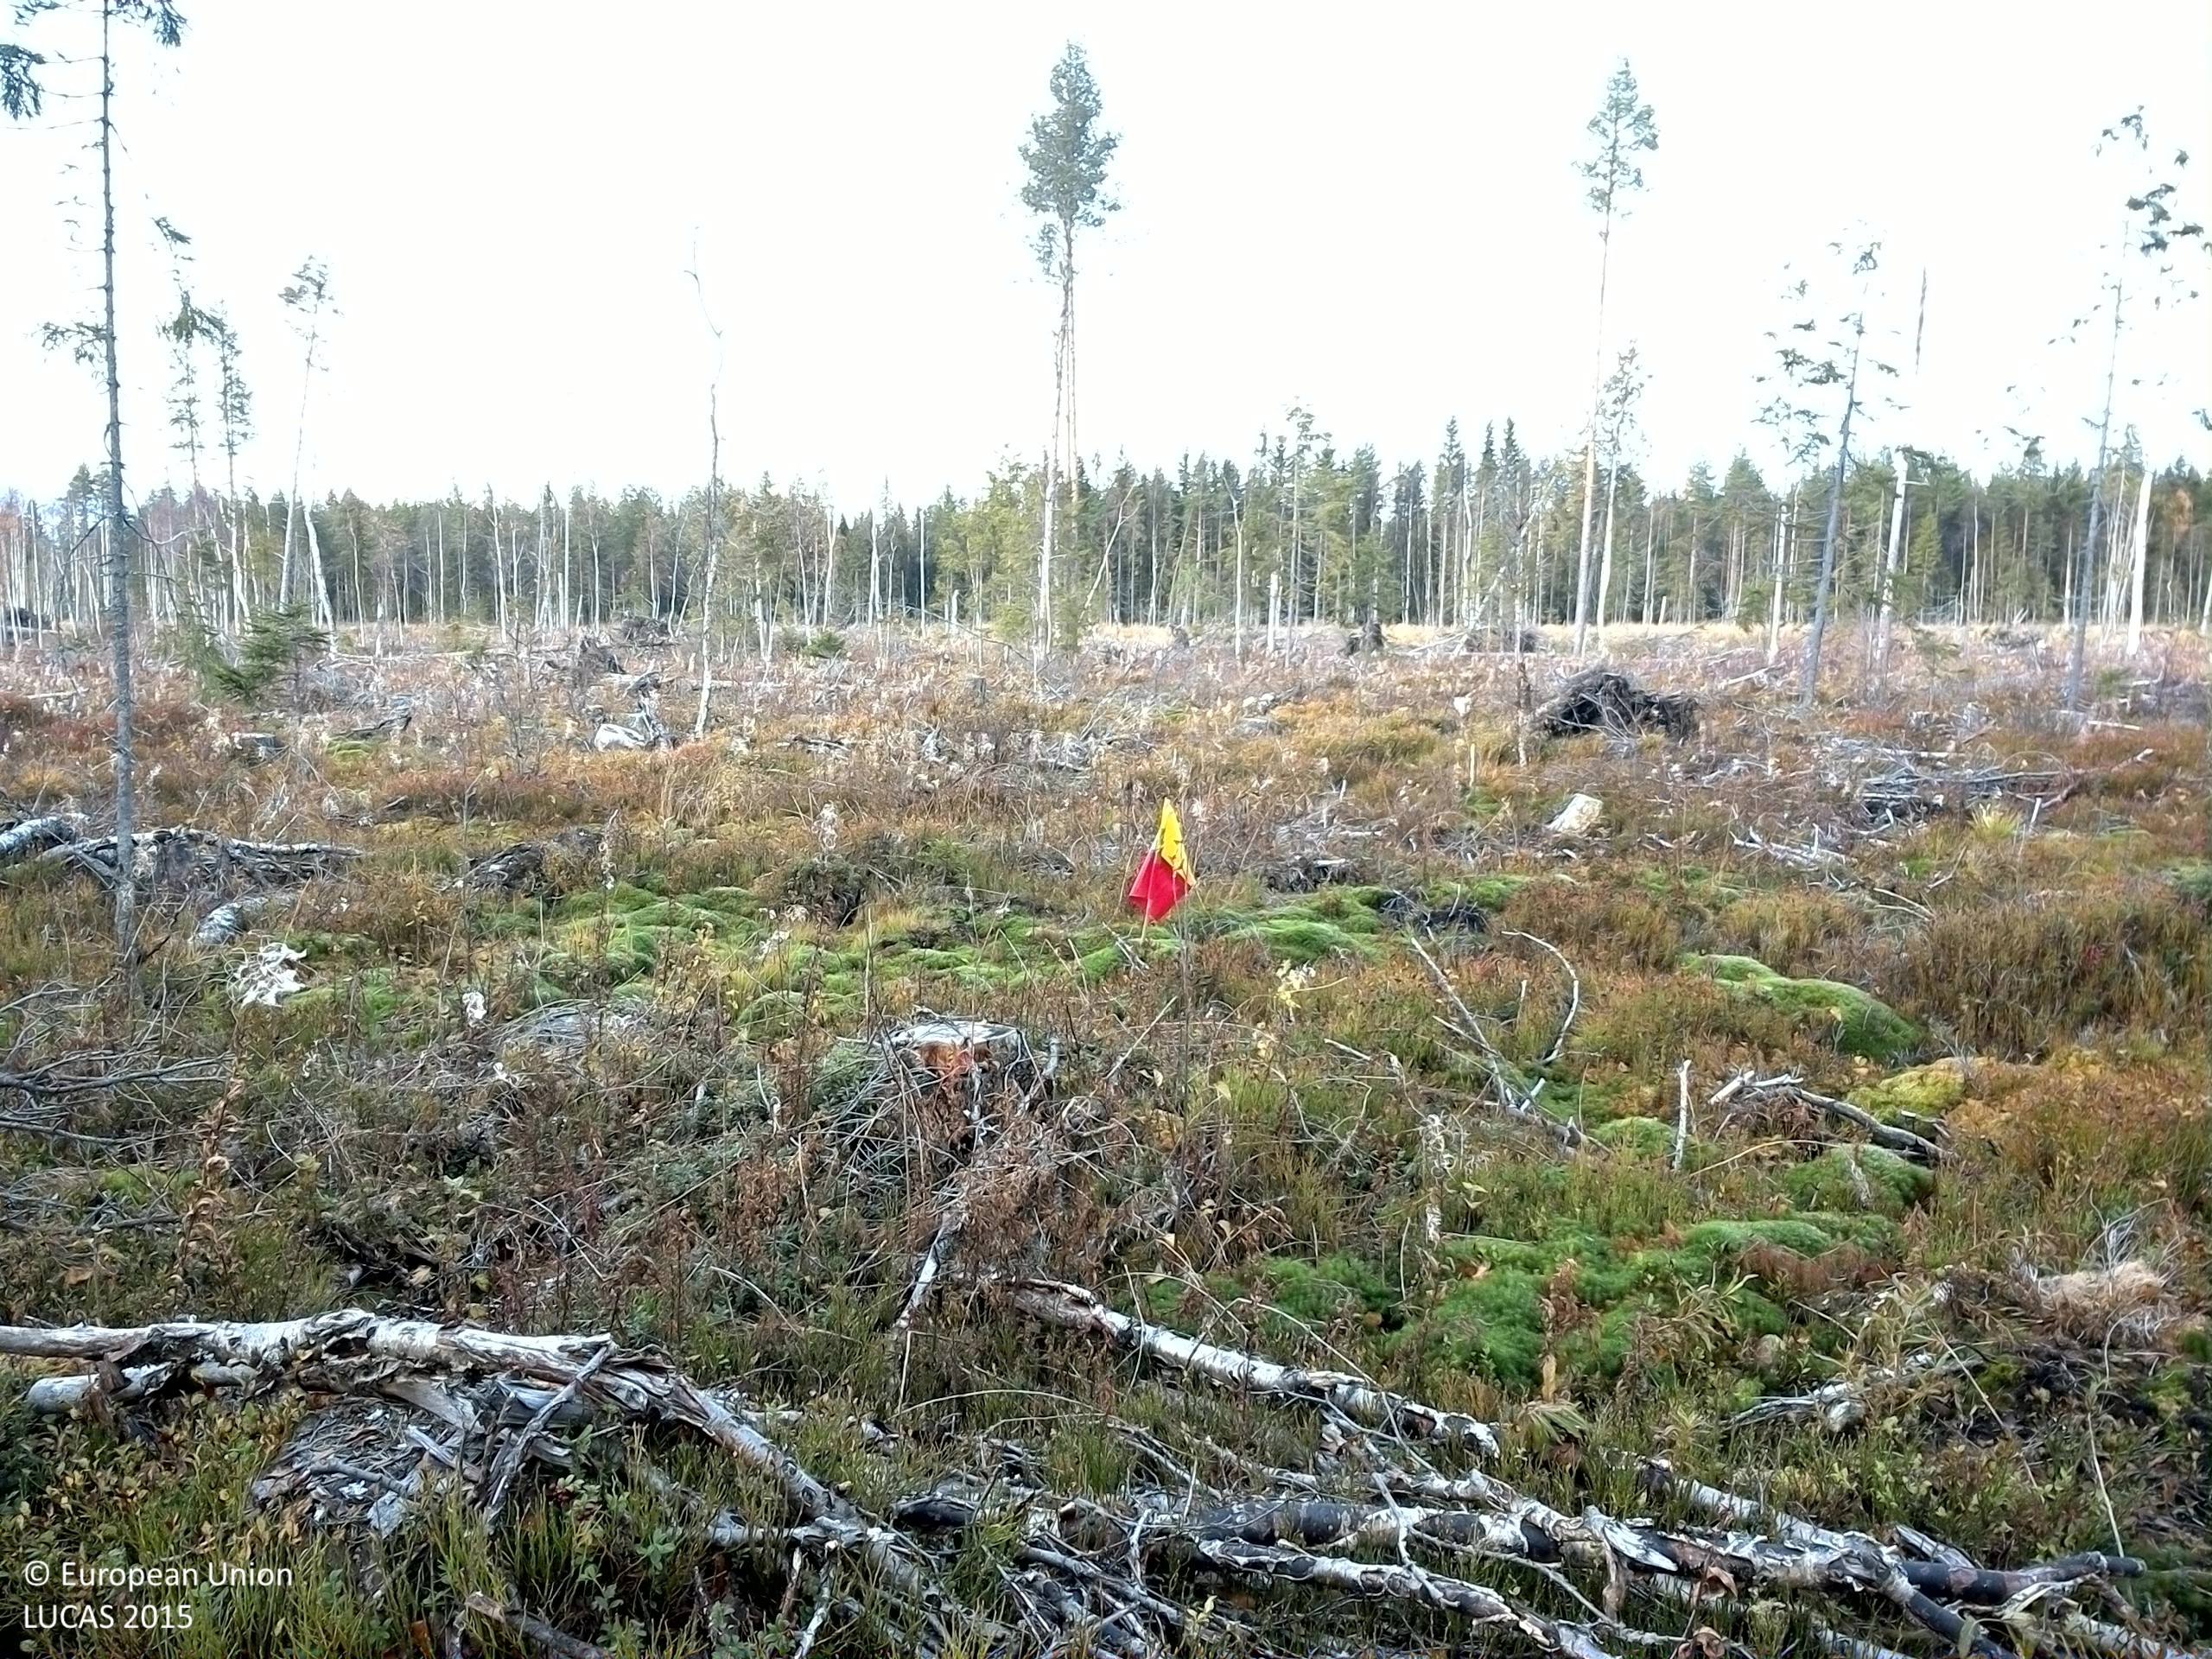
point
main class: Shrubland
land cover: Shrubland without tree cover
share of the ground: 25 - 50 %
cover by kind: shrubs 45 %, lichens and mosses 35 %, herbaceous plants 20 %
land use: Forestry
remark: Clear cut
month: October
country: SE
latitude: 64.0893
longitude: 15.8991
